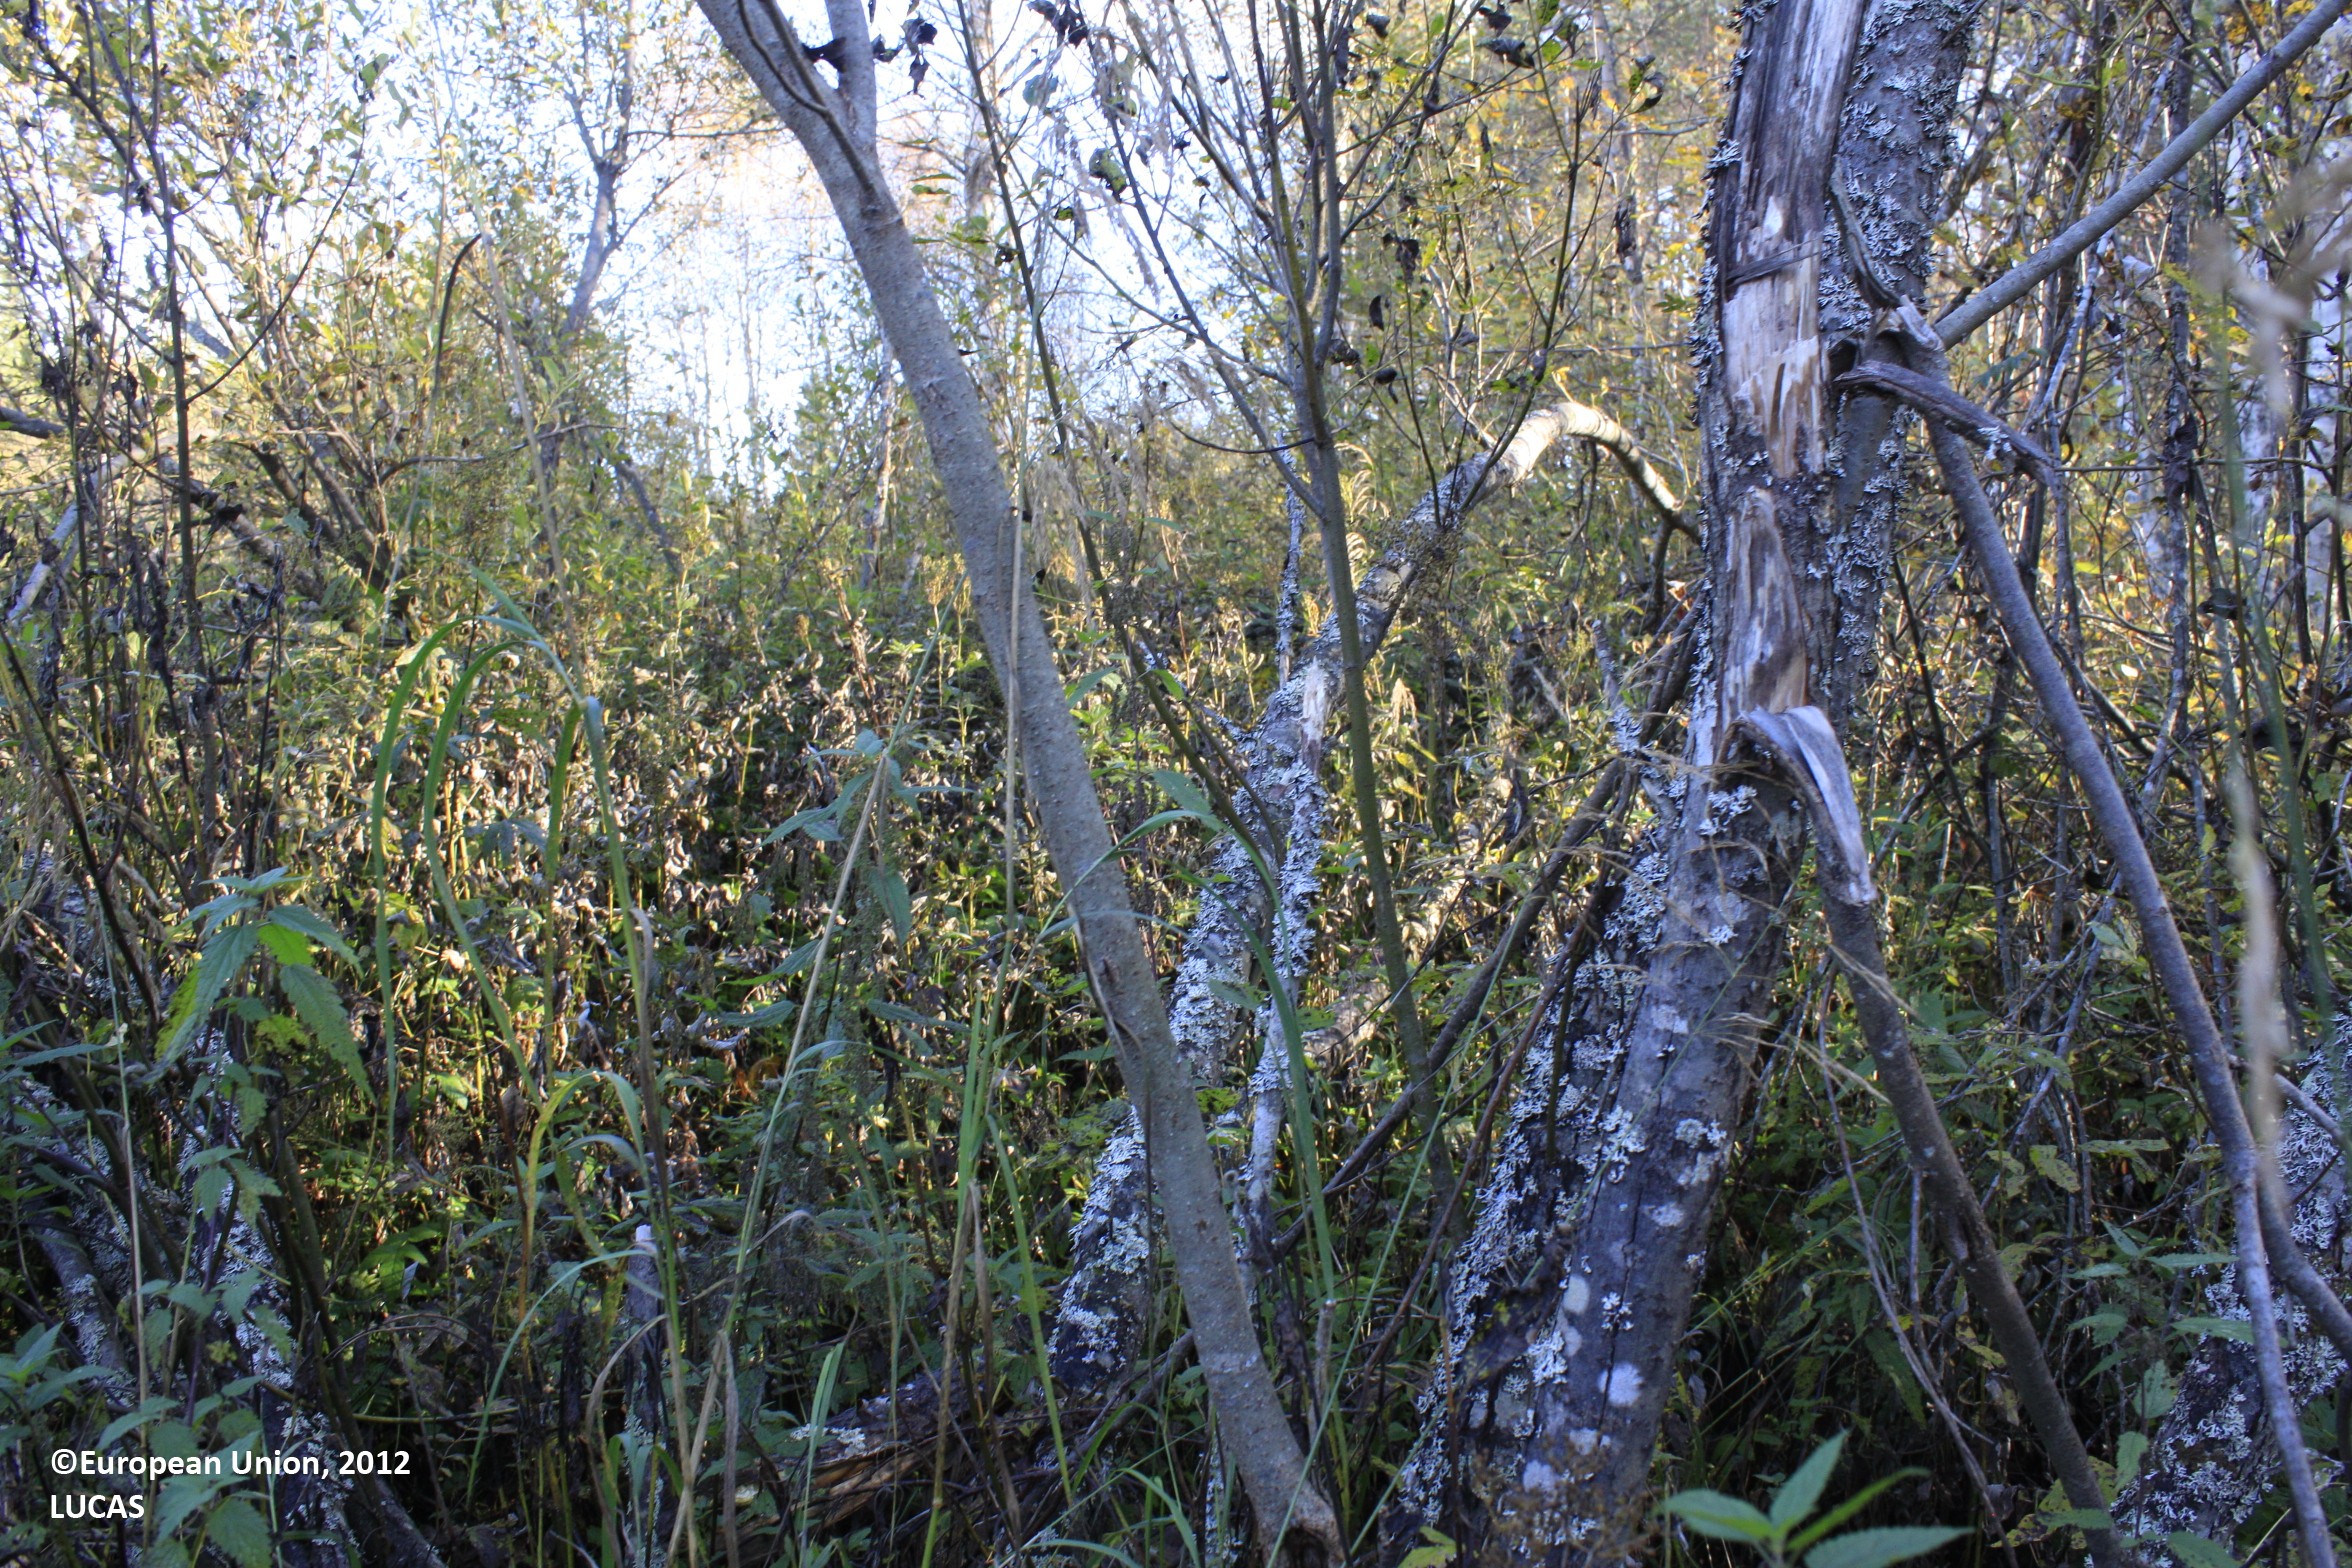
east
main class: Woodland
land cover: Pine dominated mixed woodland
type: boreal forest
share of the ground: 50 - 75 %
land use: Forestry
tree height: > 5 m
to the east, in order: Pine dominated mixed woodland; Peatbogs; Inland running water; Peatbogs; Pine dominated mixed woodland; Ditches and canals; Tracks
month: September
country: FI
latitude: 63.7030
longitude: 25.8683
